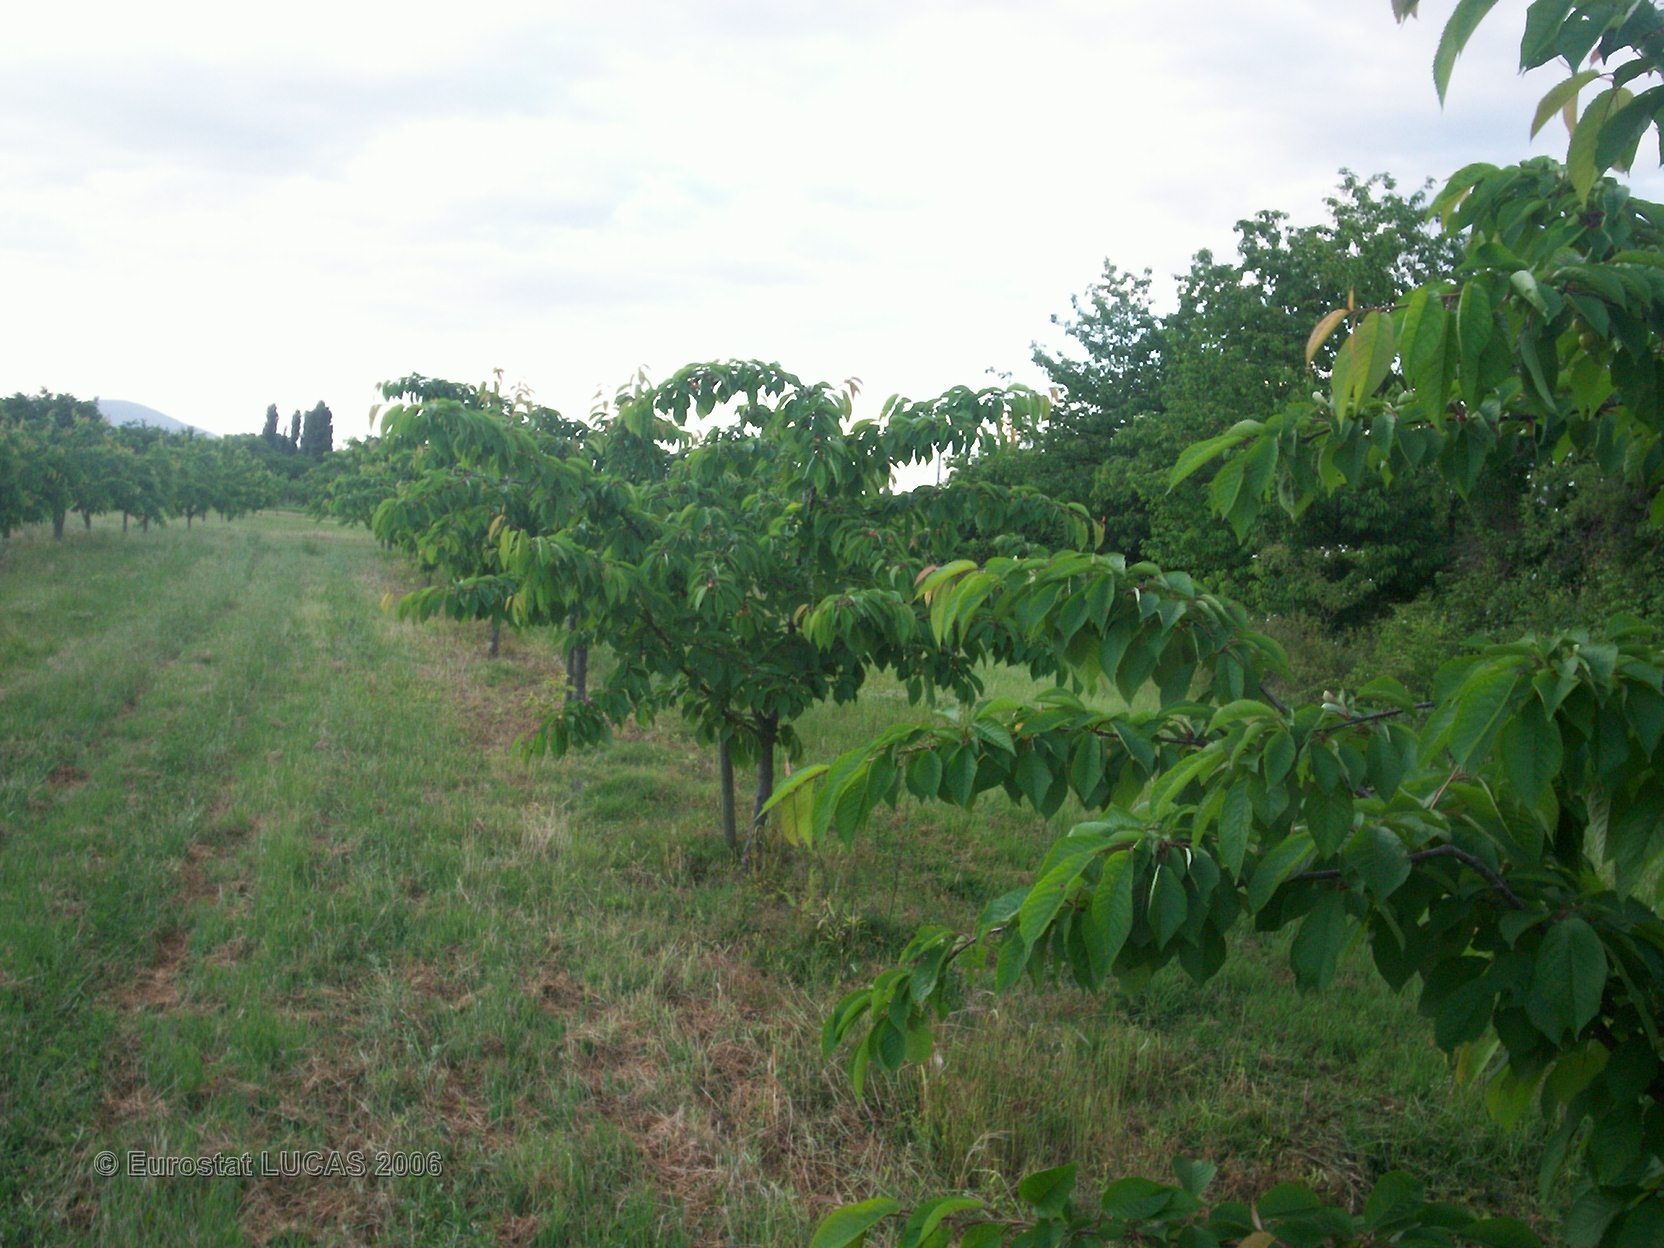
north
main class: Cropland
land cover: Cherry fruit
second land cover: Grassland with sparse tree/shrub cover
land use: Agriculture (excluding fallow land and kitchen gardens)
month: May
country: FR
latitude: 45.3561
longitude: 4.7580
